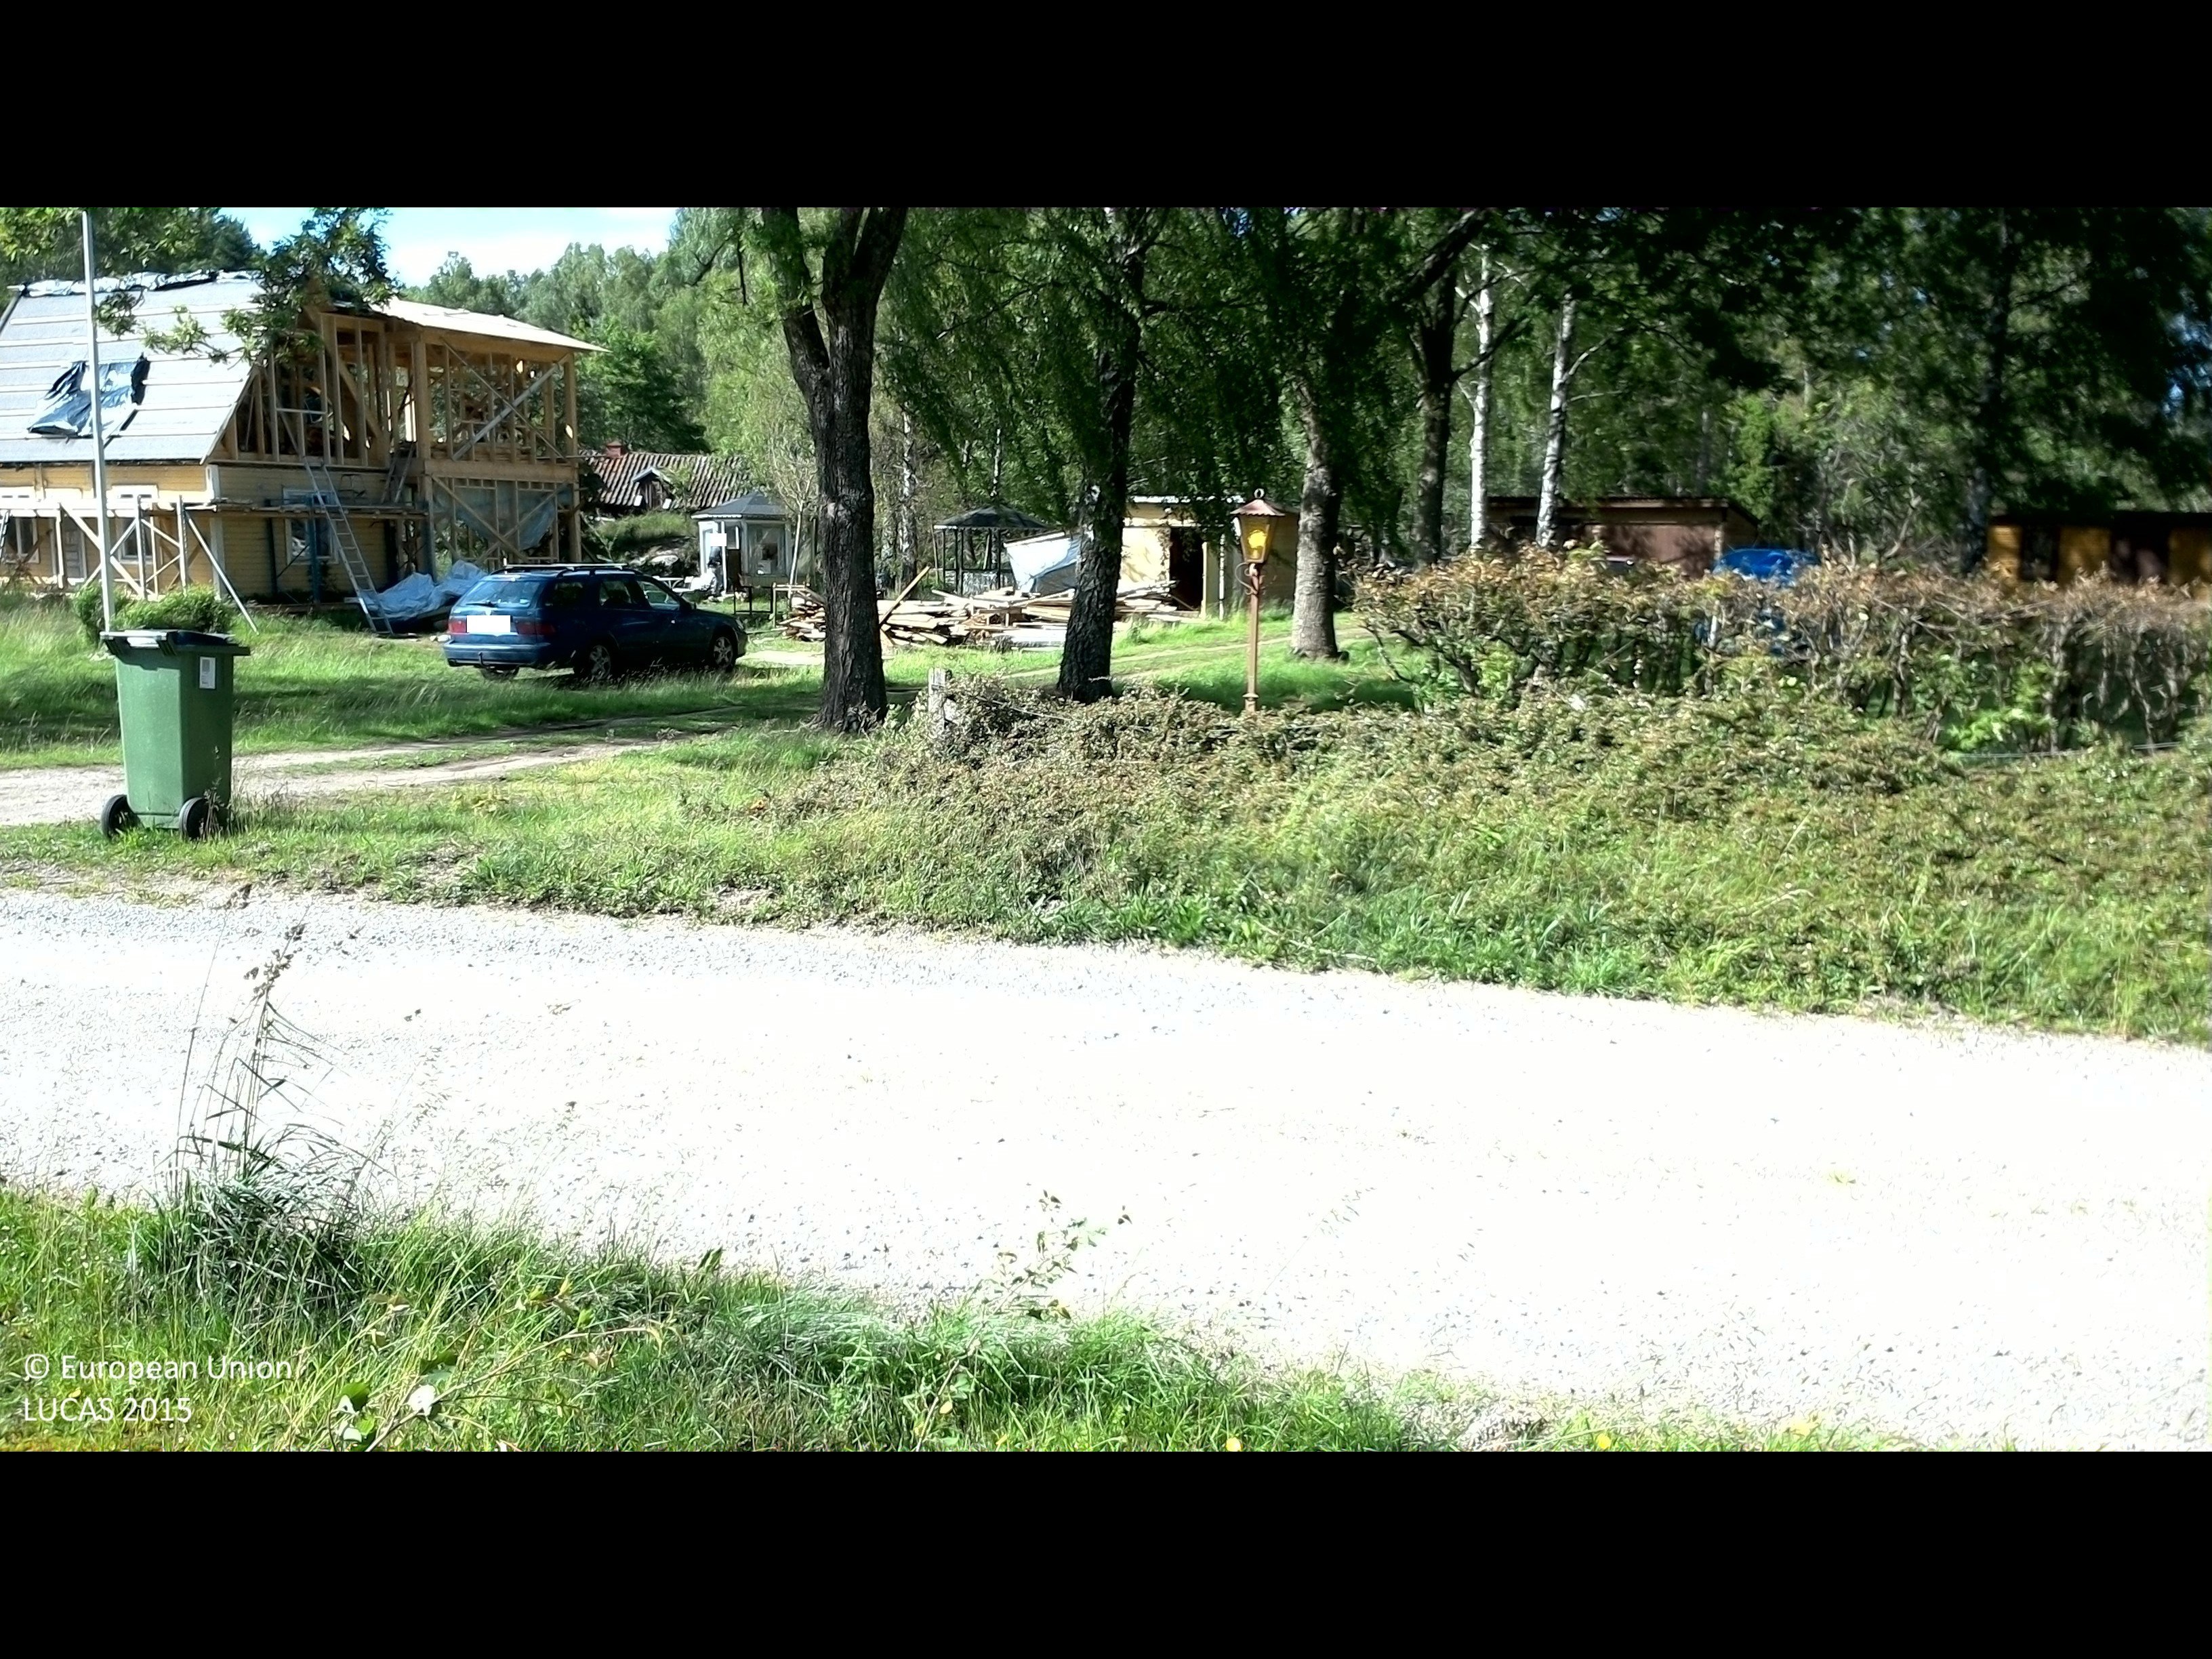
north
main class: Grassland
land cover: Grassland with sparse tree/shrub cover
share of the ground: > 75 %
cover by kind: herbaceous plants 85 %, broadleaved forest trees 5 %
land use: Residential
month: June
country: SE
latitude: 56.3225
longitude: 15.9023
